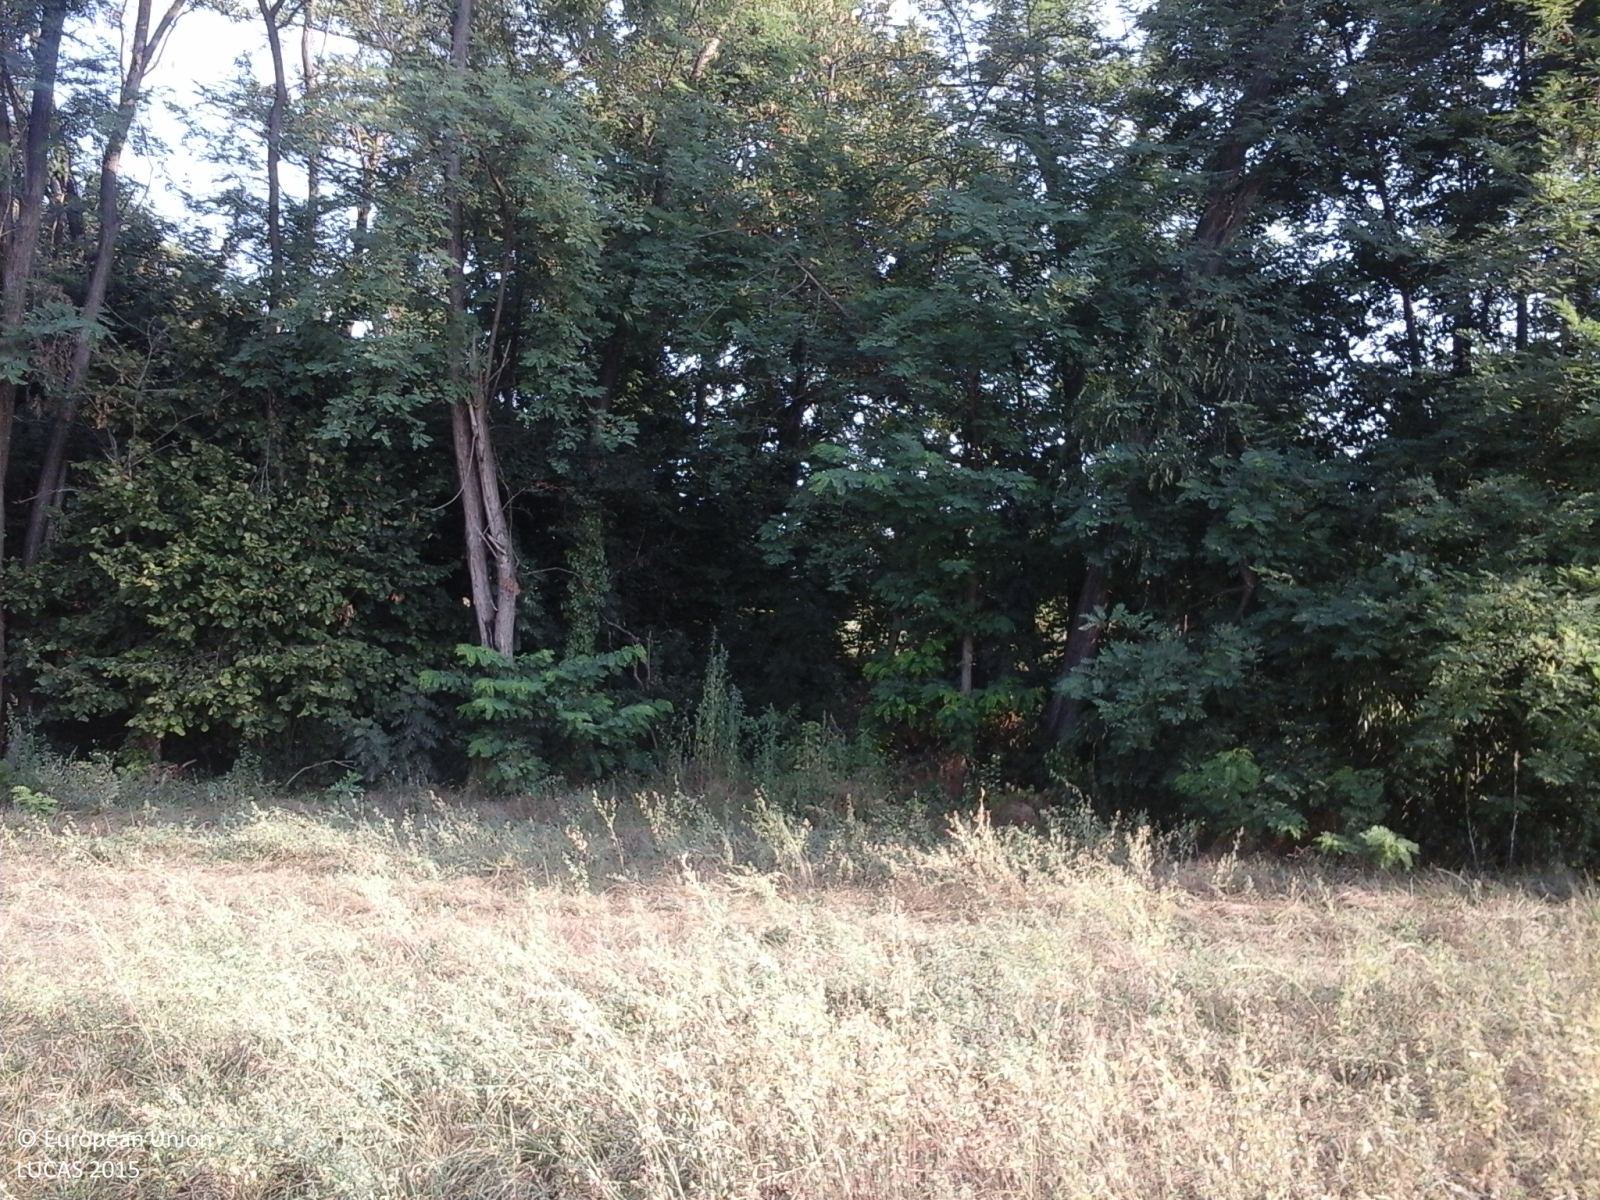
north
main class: Grassland
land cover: Grassland without tree/shrub cover
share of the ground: > 75 %
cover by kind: herbaceous plants 100 %
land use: Agriculture (excluding fallow land and kitchen gardens)
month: August
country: IT
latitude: 44.4176
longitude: 7.8068
